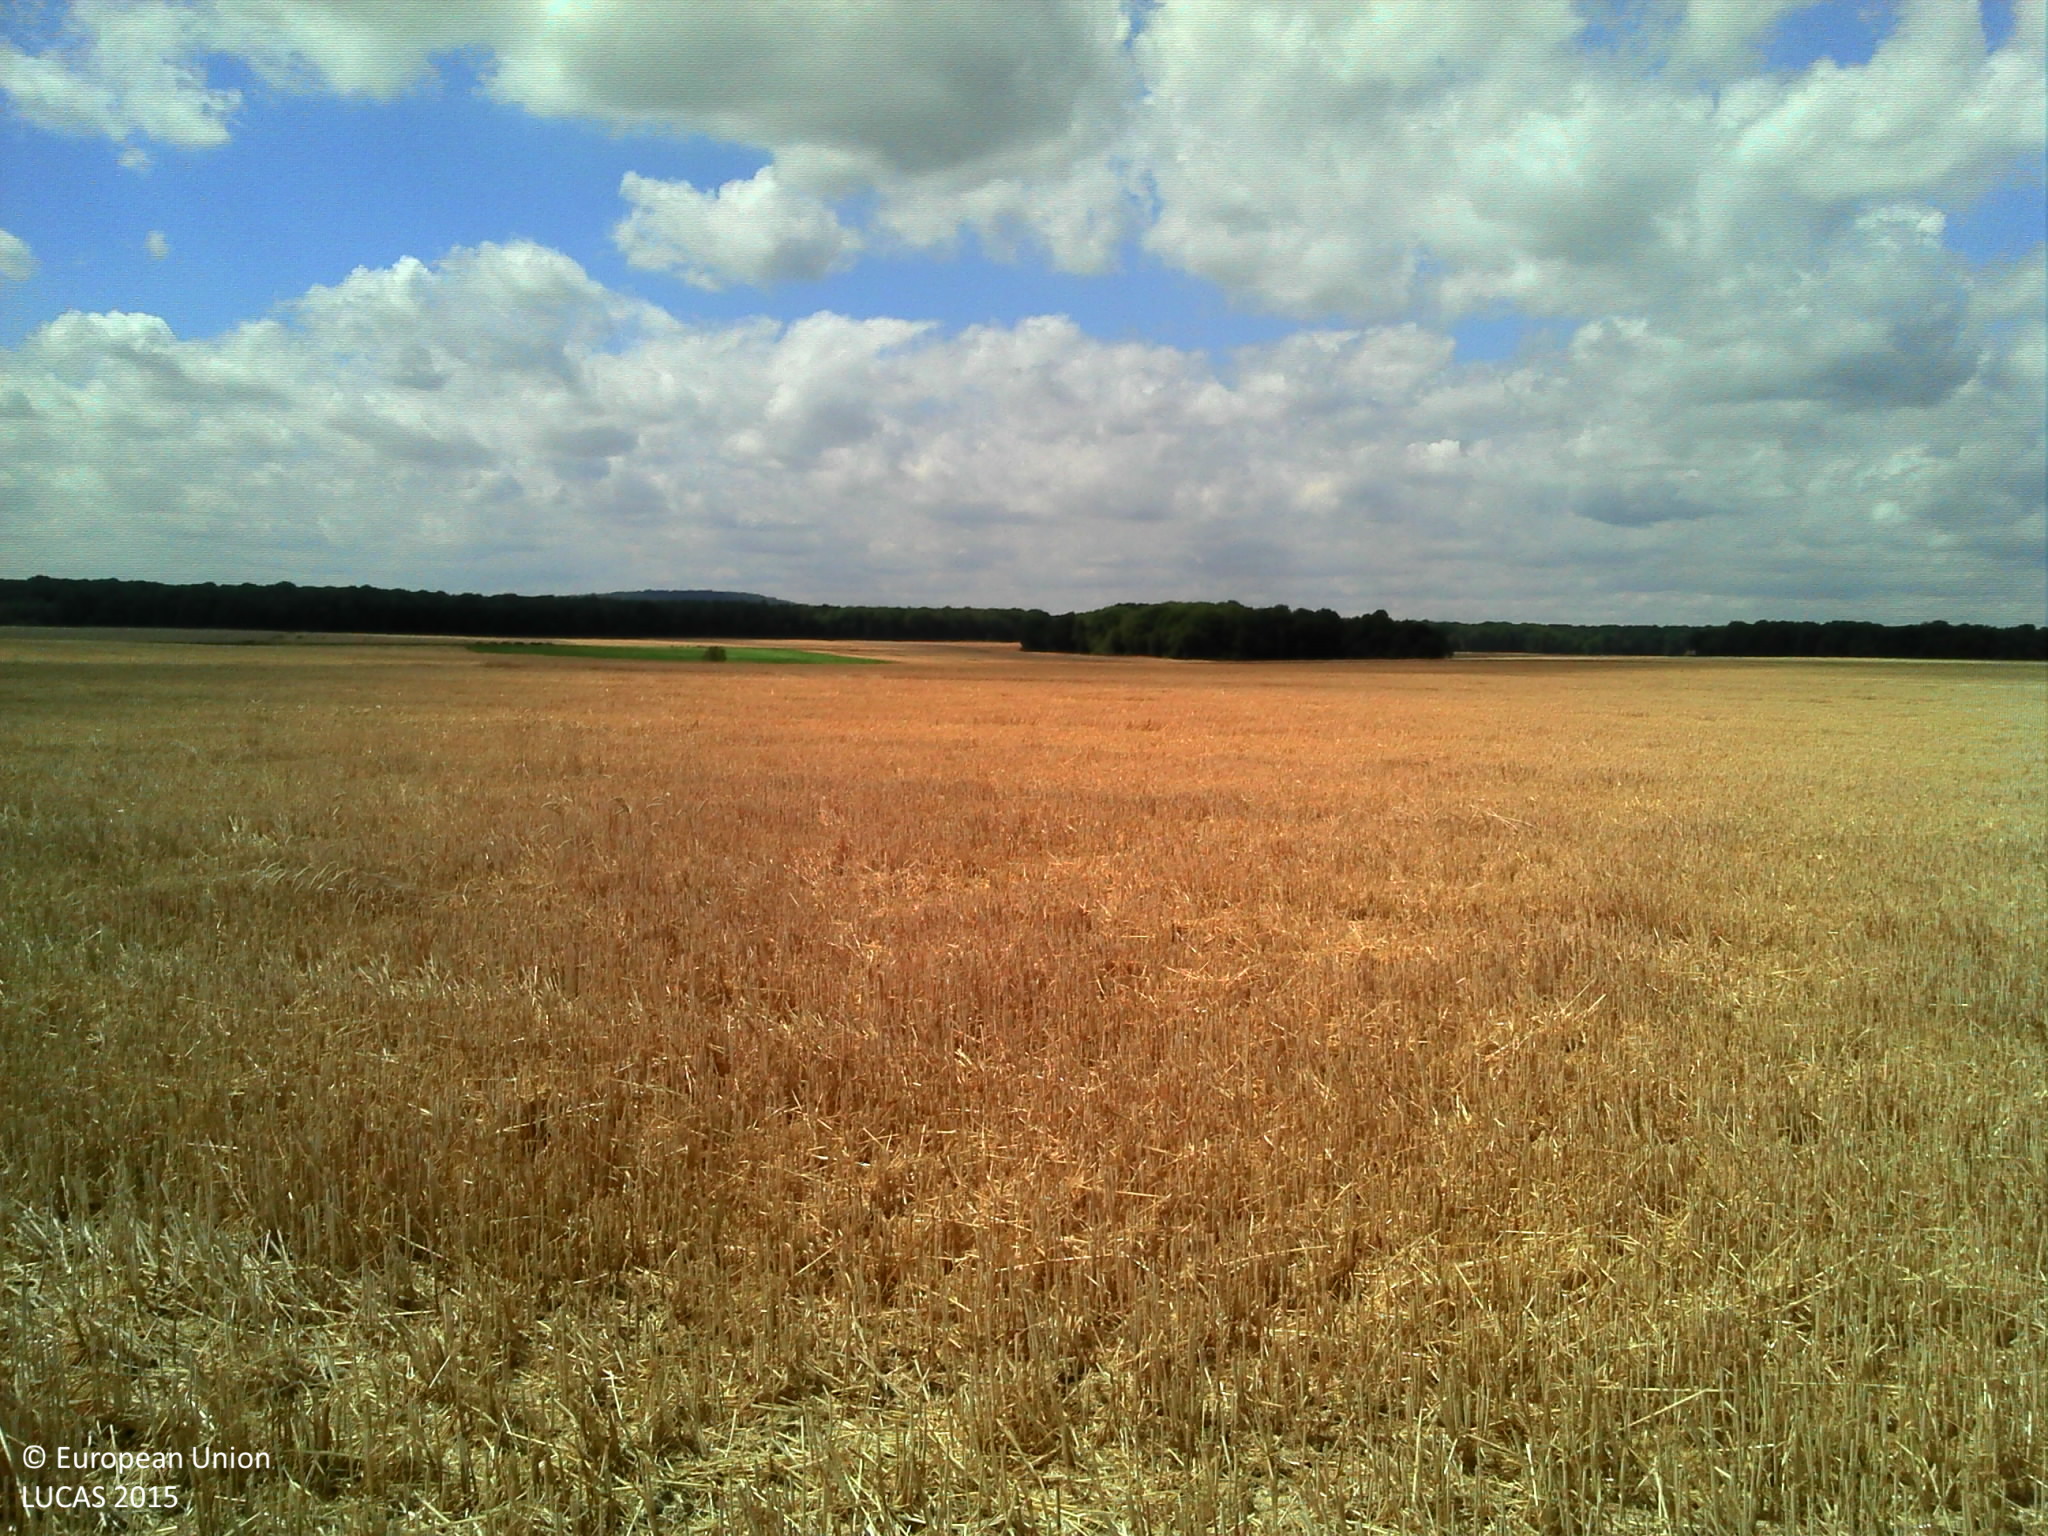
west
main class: Cropland
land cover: Common wheat
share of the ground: > 75 %
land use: Agriculture (excluding fallow land and kitchen gardens)
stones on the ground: < 10 %
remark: Harvested field
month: July
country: FR
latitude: 49.0988
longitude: 2.6619
